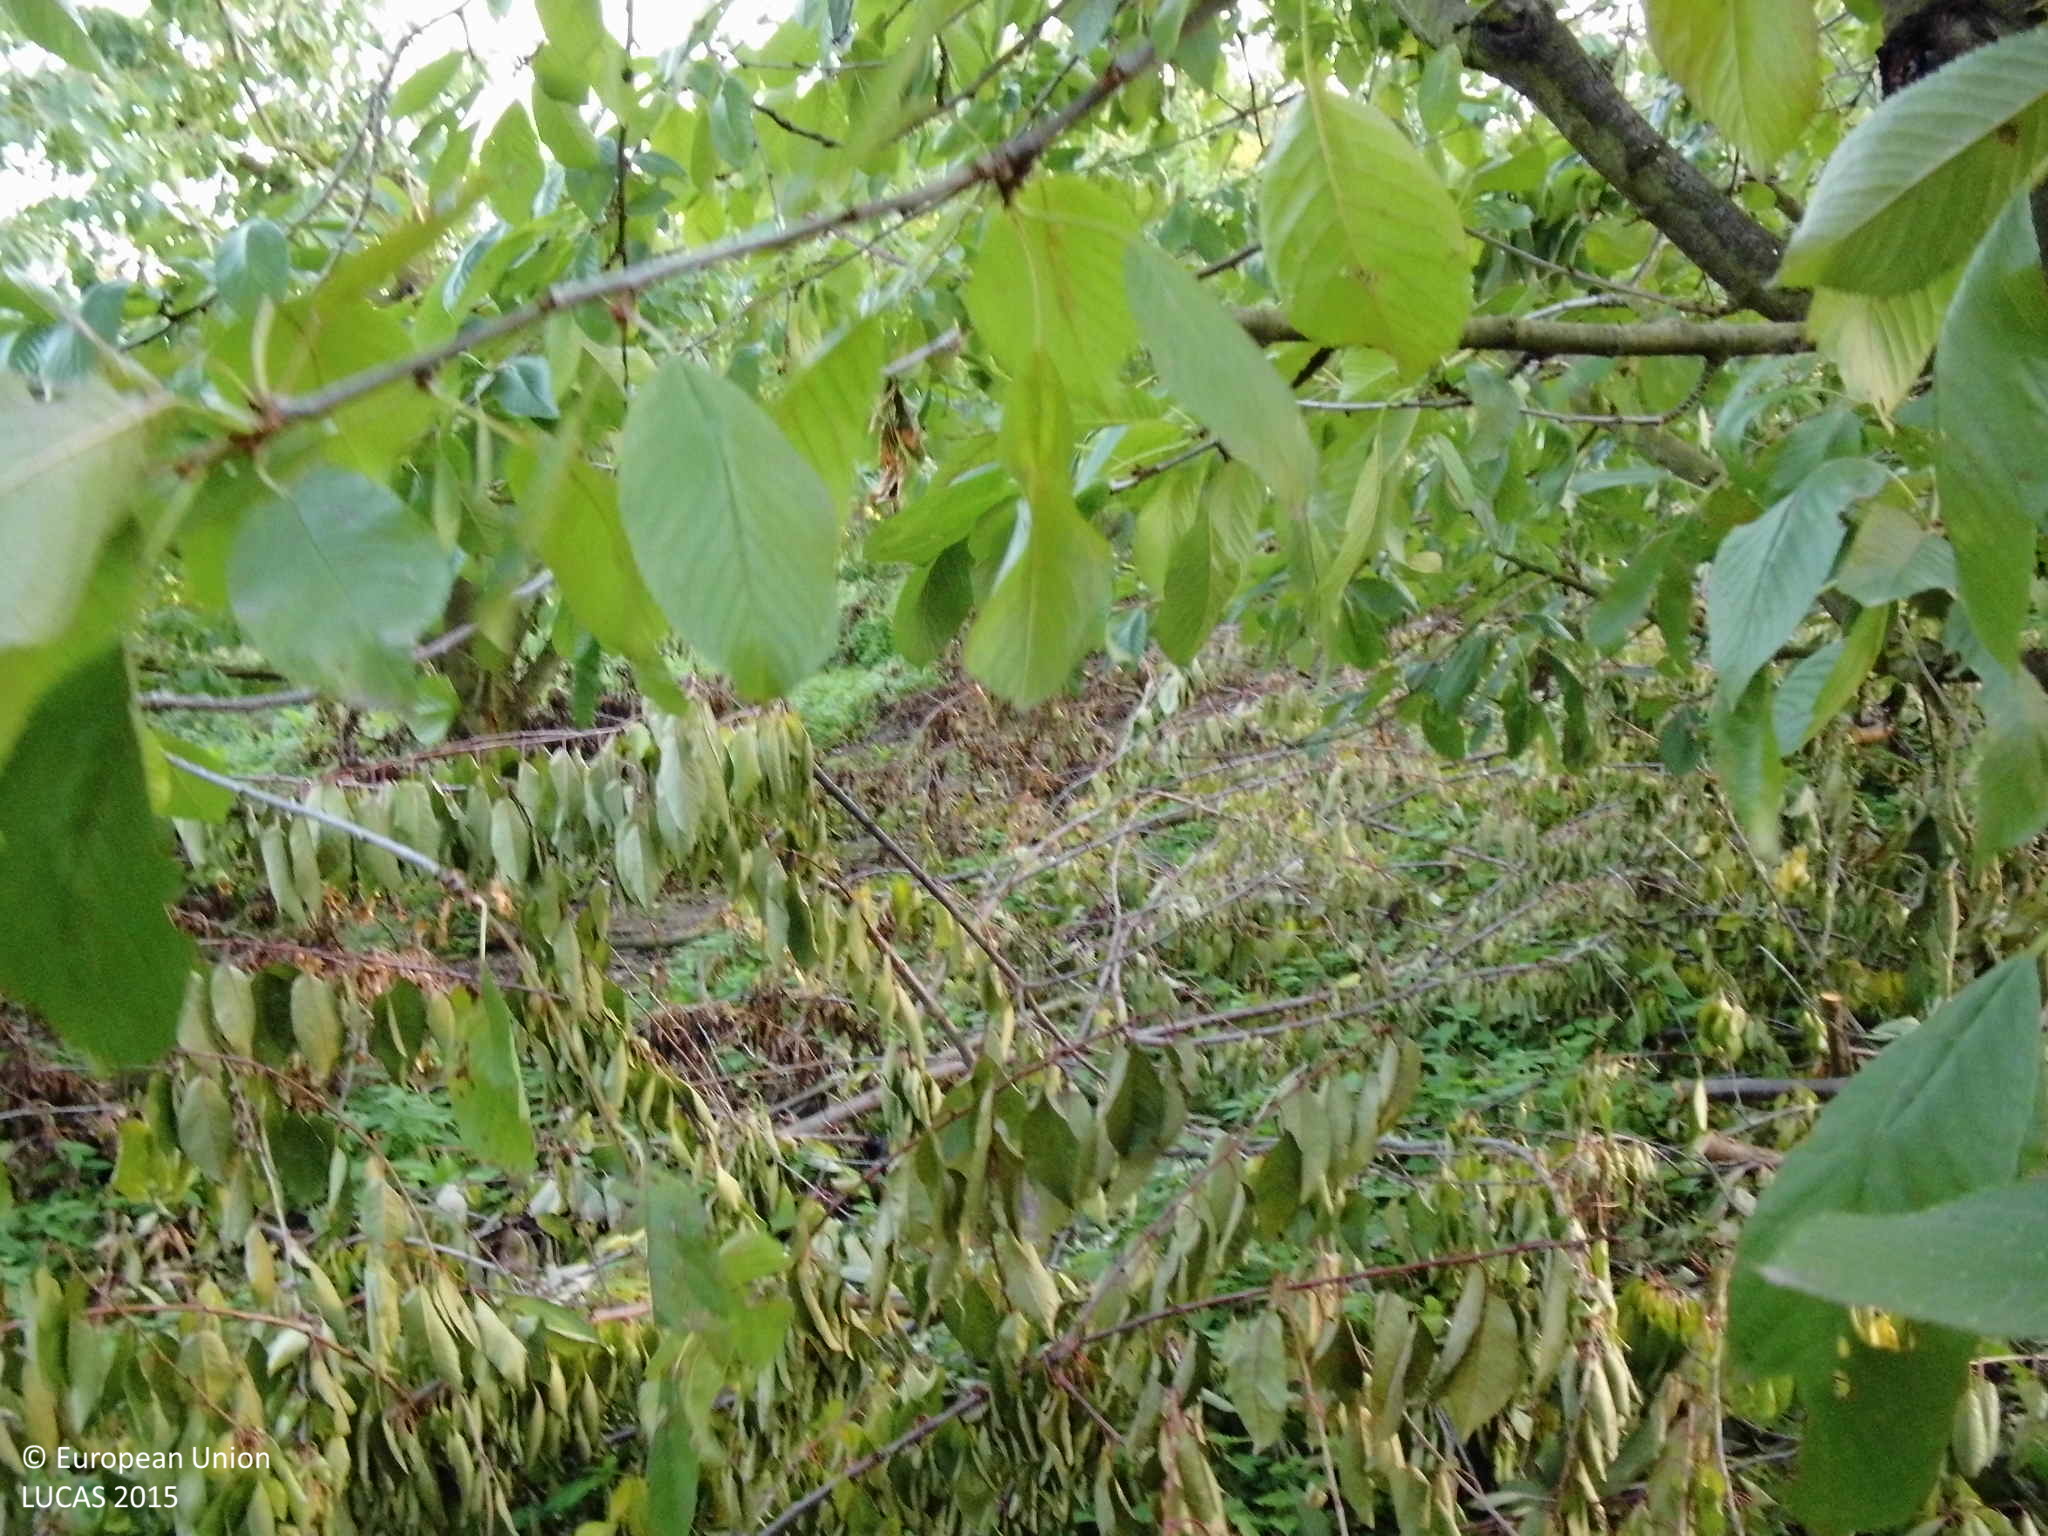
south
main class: Cropland
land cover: Cherry fruit
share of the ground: > 75 %
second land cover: Grassland without tree/shrub cover
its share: > 75 %
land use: Agriculture (excluding fallow land and kitchen gardens)
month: September
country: DE
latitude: 50.3897
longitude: 7.4544
